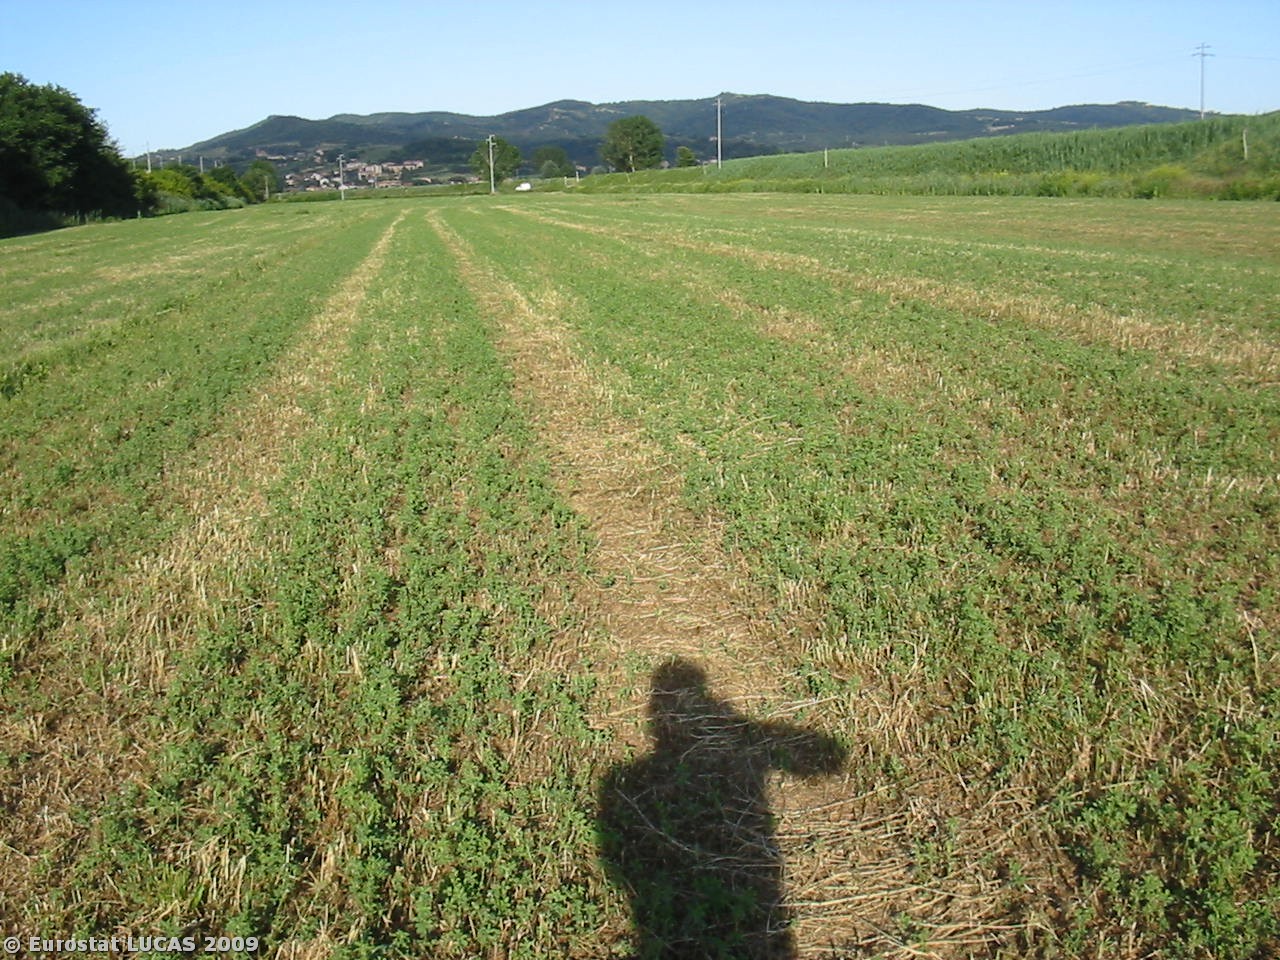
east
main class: Cropland
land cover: Lucerne
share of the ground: > 75 %
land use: Agriculture (excluding fallow land and kitchen gardens)
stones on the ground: < 10 %
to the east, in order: Lucerne; Ditches and canals; Lucerne
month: May
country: IT
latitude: 43.0137
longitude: 11.9939
